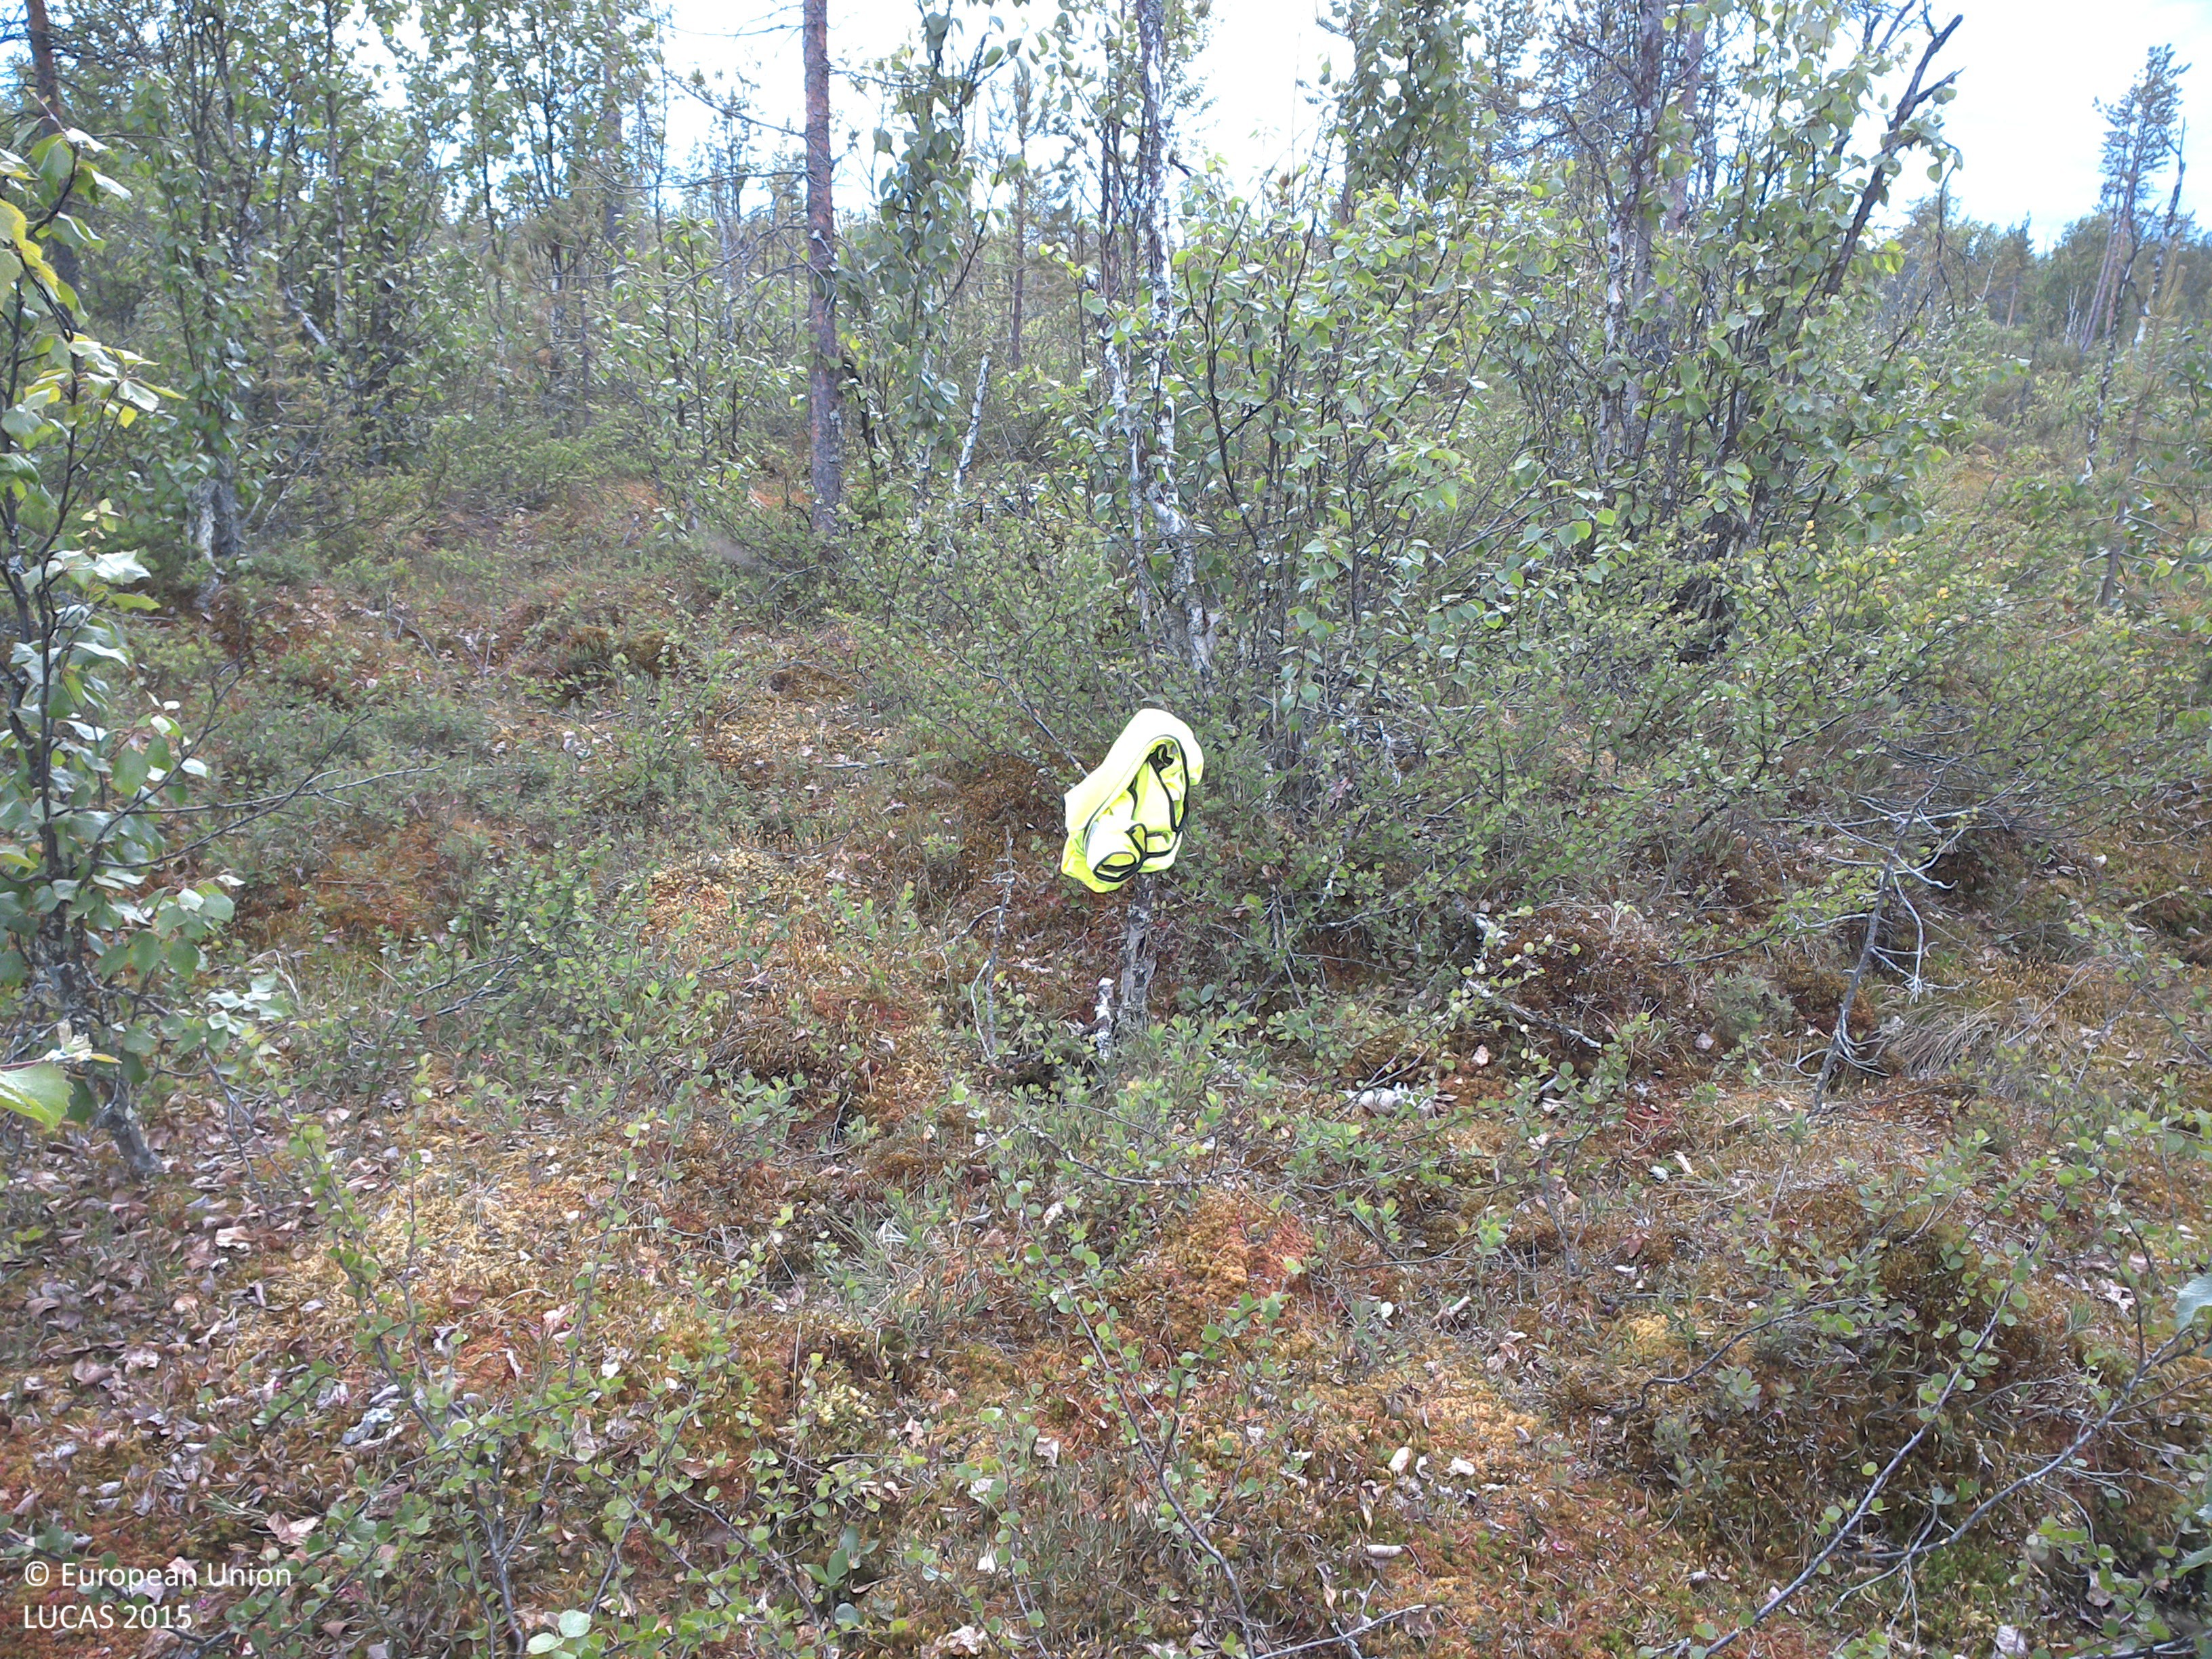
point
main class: Woodland
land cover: Other mixed woodland
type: boreal forest
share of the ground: 10 - 25 %
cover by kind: lichens and mosses 45 %, shrubs 35 %, coniferous forest trees 10 %, broadleaved forest trees 10 %
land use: Forestry
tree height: < 5 m
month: July
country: SE
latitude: 67.2439
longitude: 23.2444
